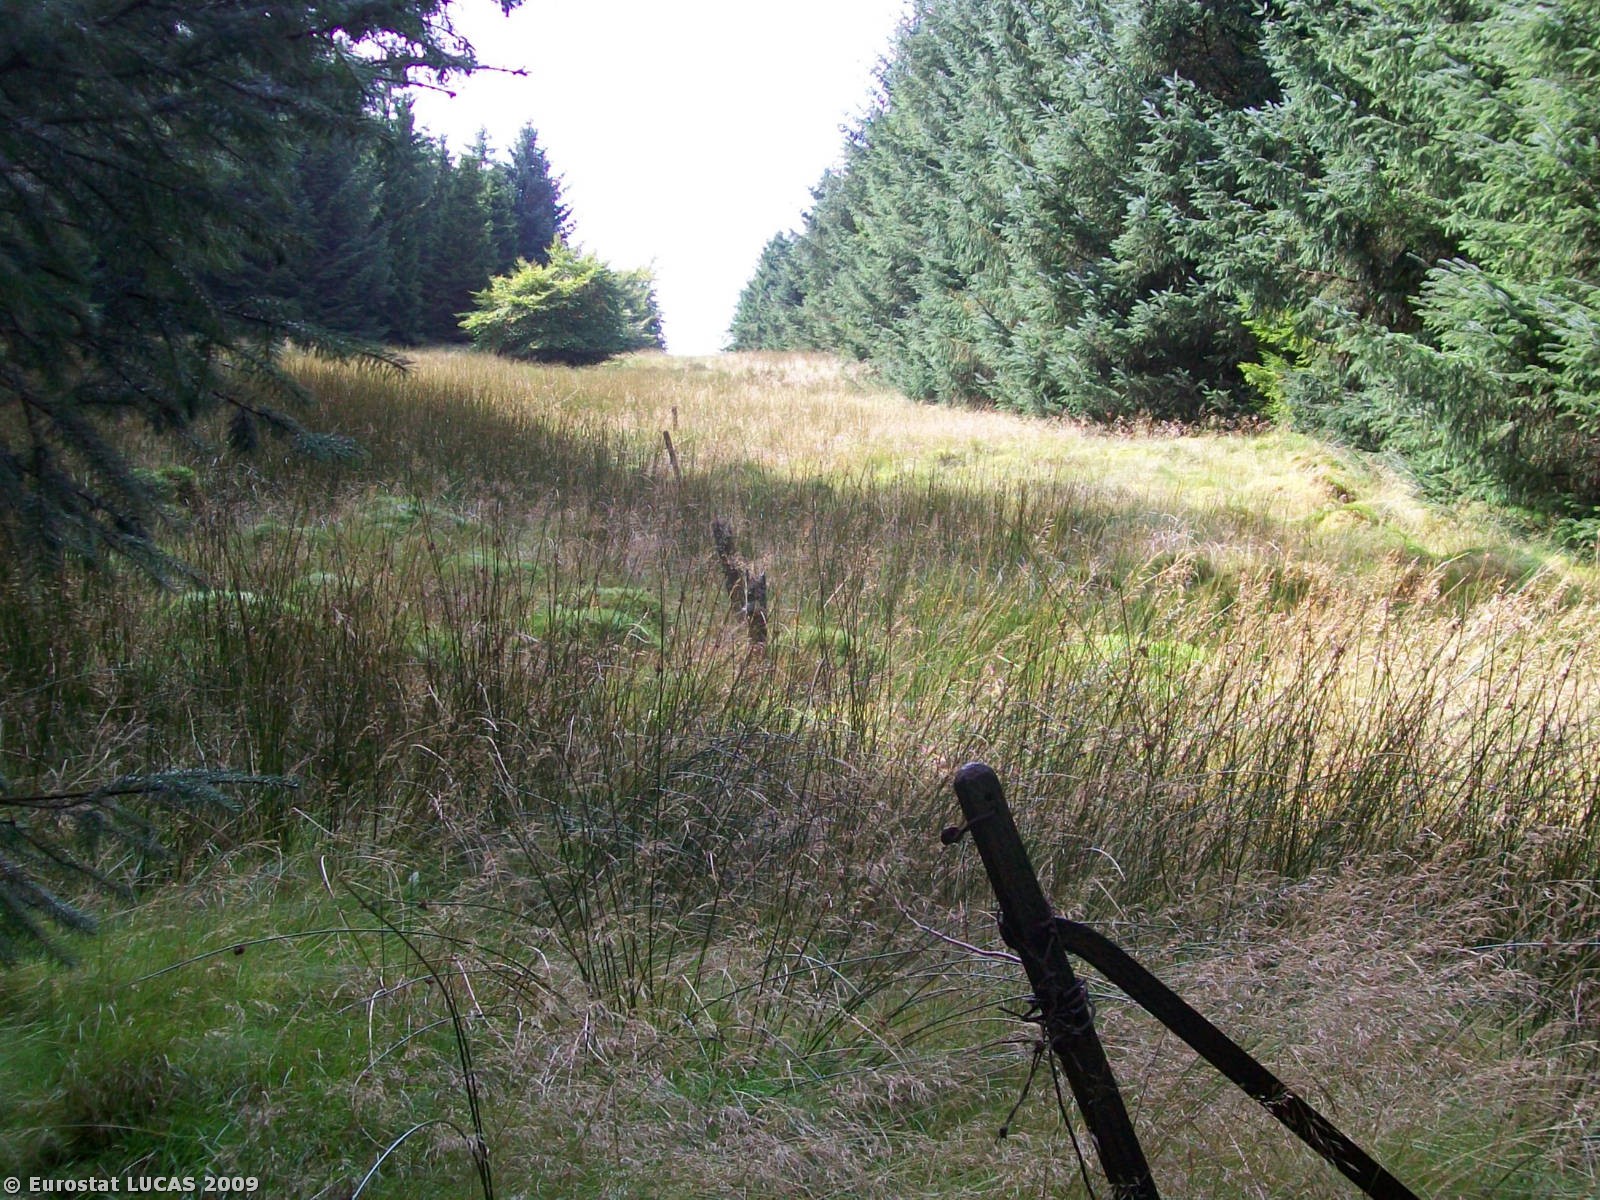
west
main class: Woodland
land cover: Coniferous woodland
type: plantations and self-sown exotic forest
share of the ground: > 75 %
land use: Forestry
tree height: > 5 m
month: September
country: GB
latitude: 55.5830
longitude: -4.2936
